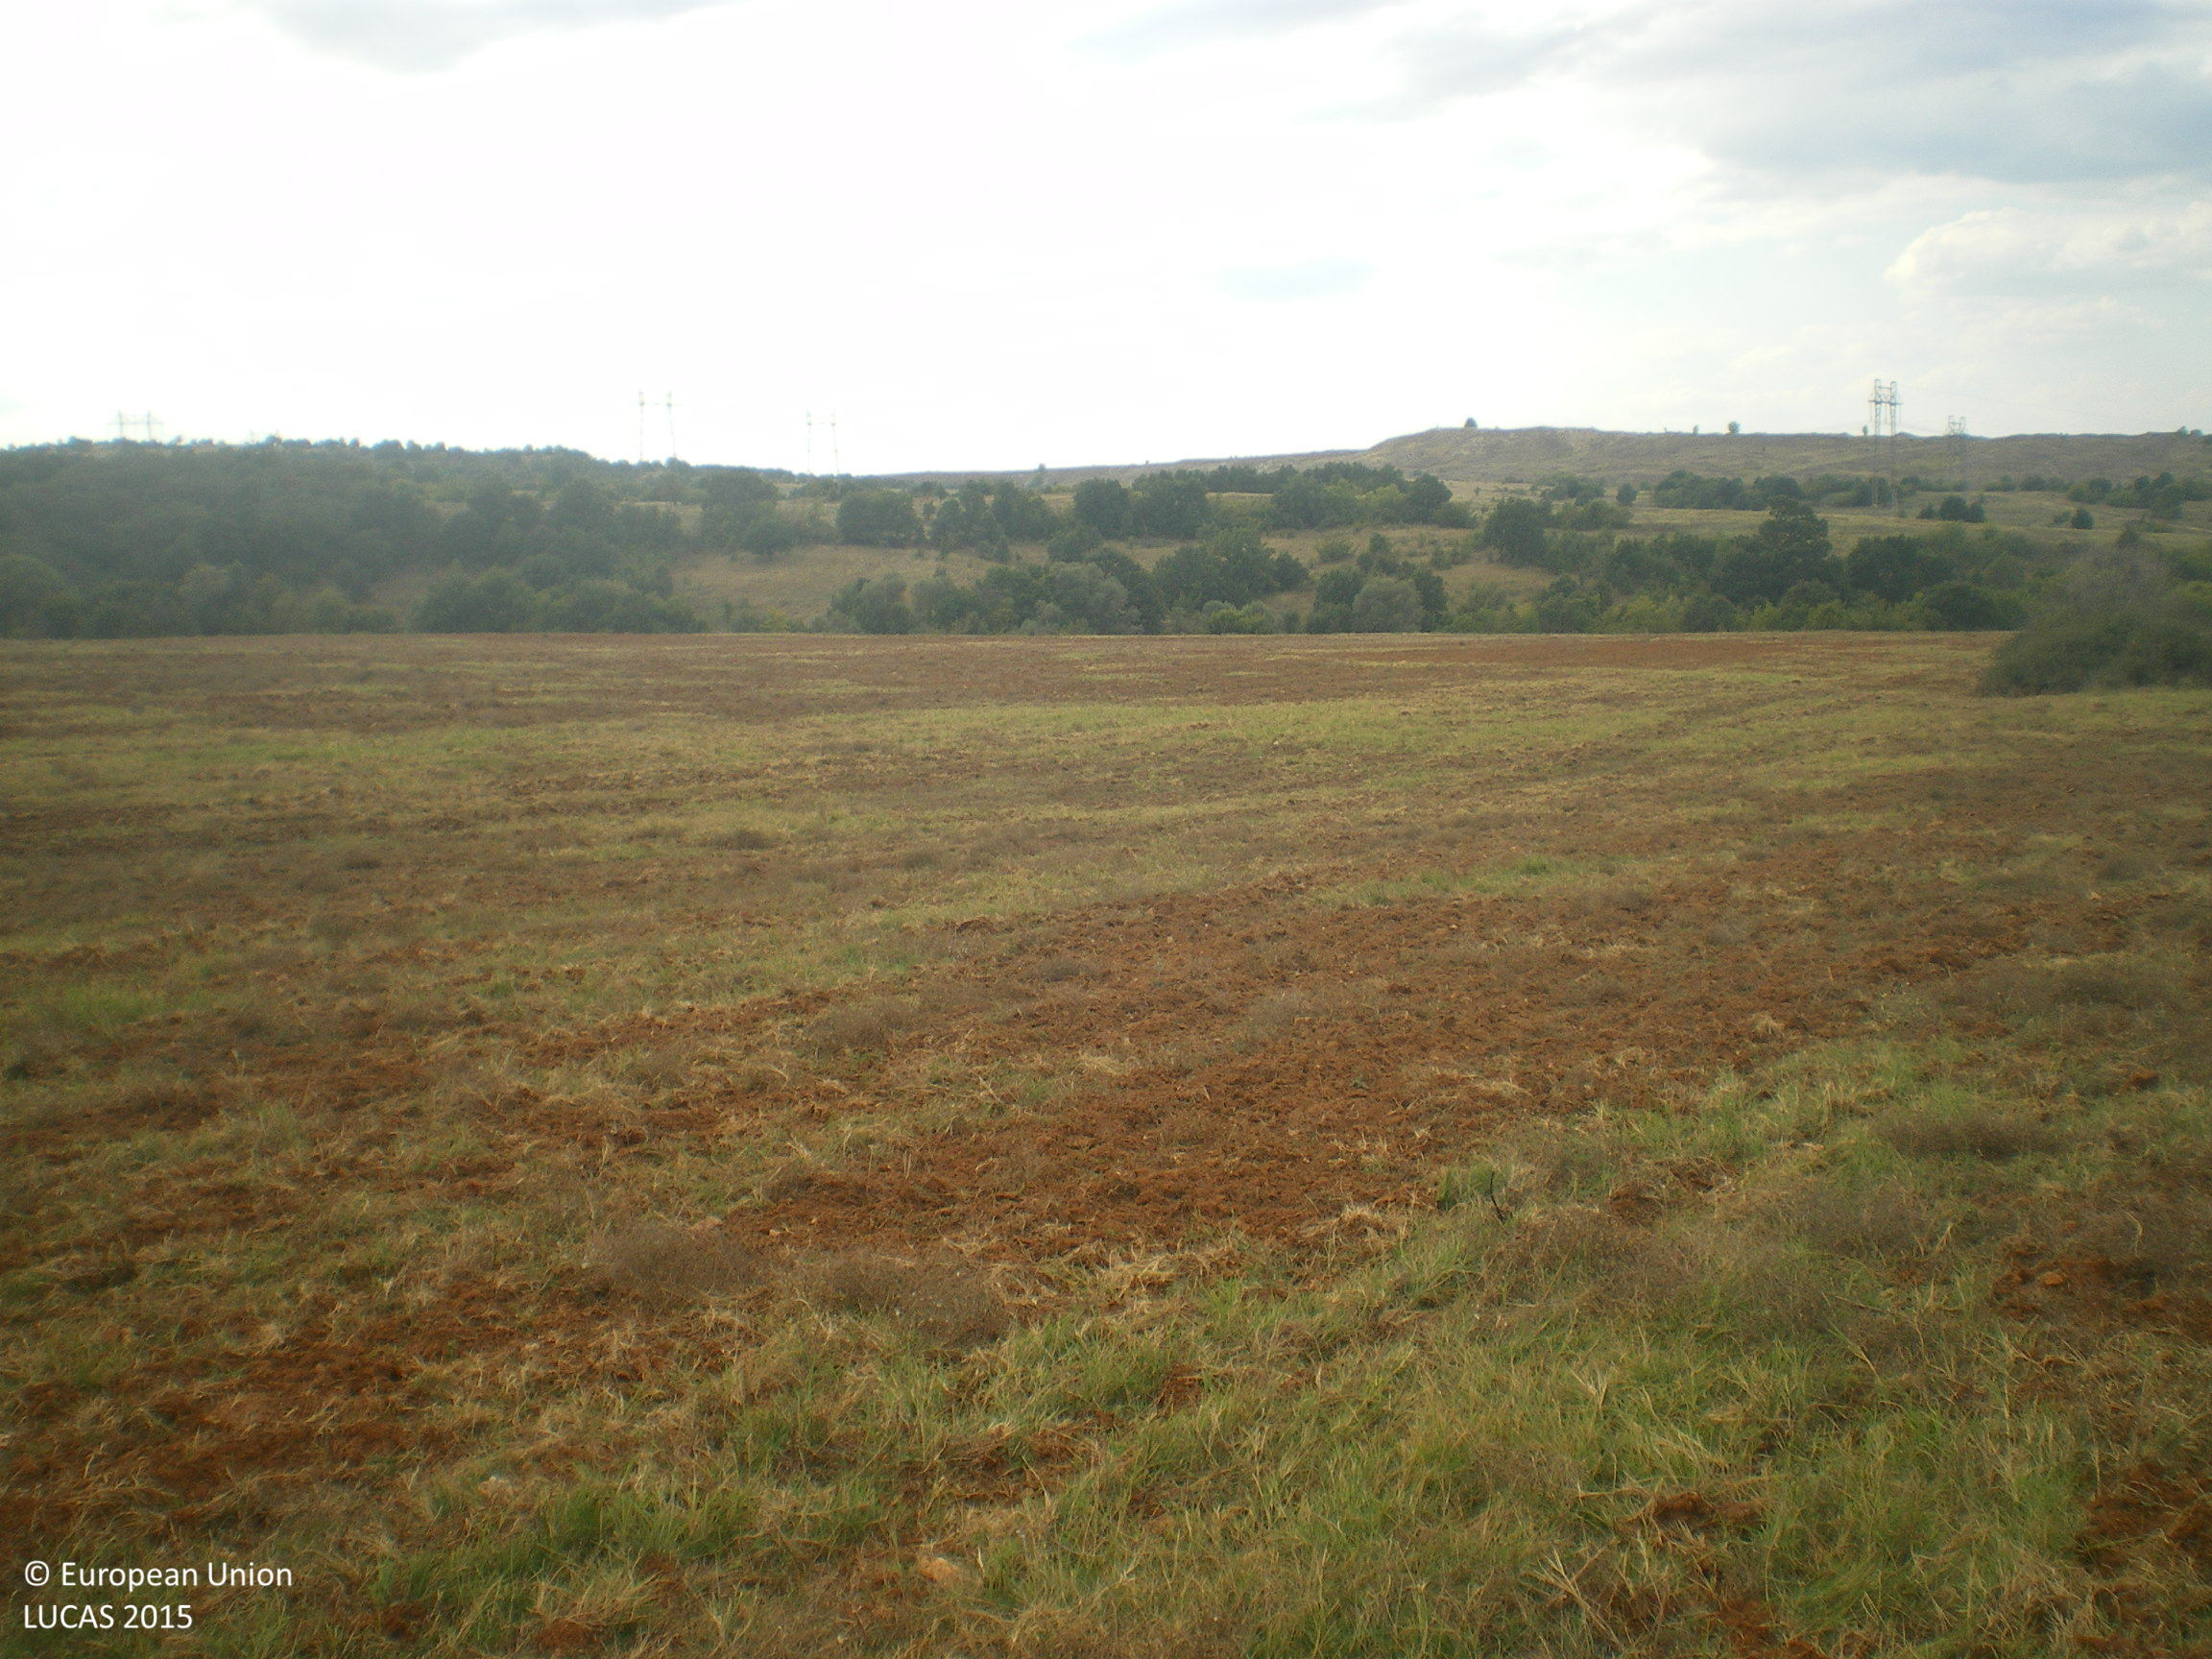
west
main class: Grassland
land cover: Spontaneously vegetated surfaces
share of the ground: > 75 %
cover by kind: herbaceous plants 95 %, unconsolidated bare surface 5 %
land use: Fallow land
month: September
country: BG
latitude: 42.0742
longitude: 26.0925
